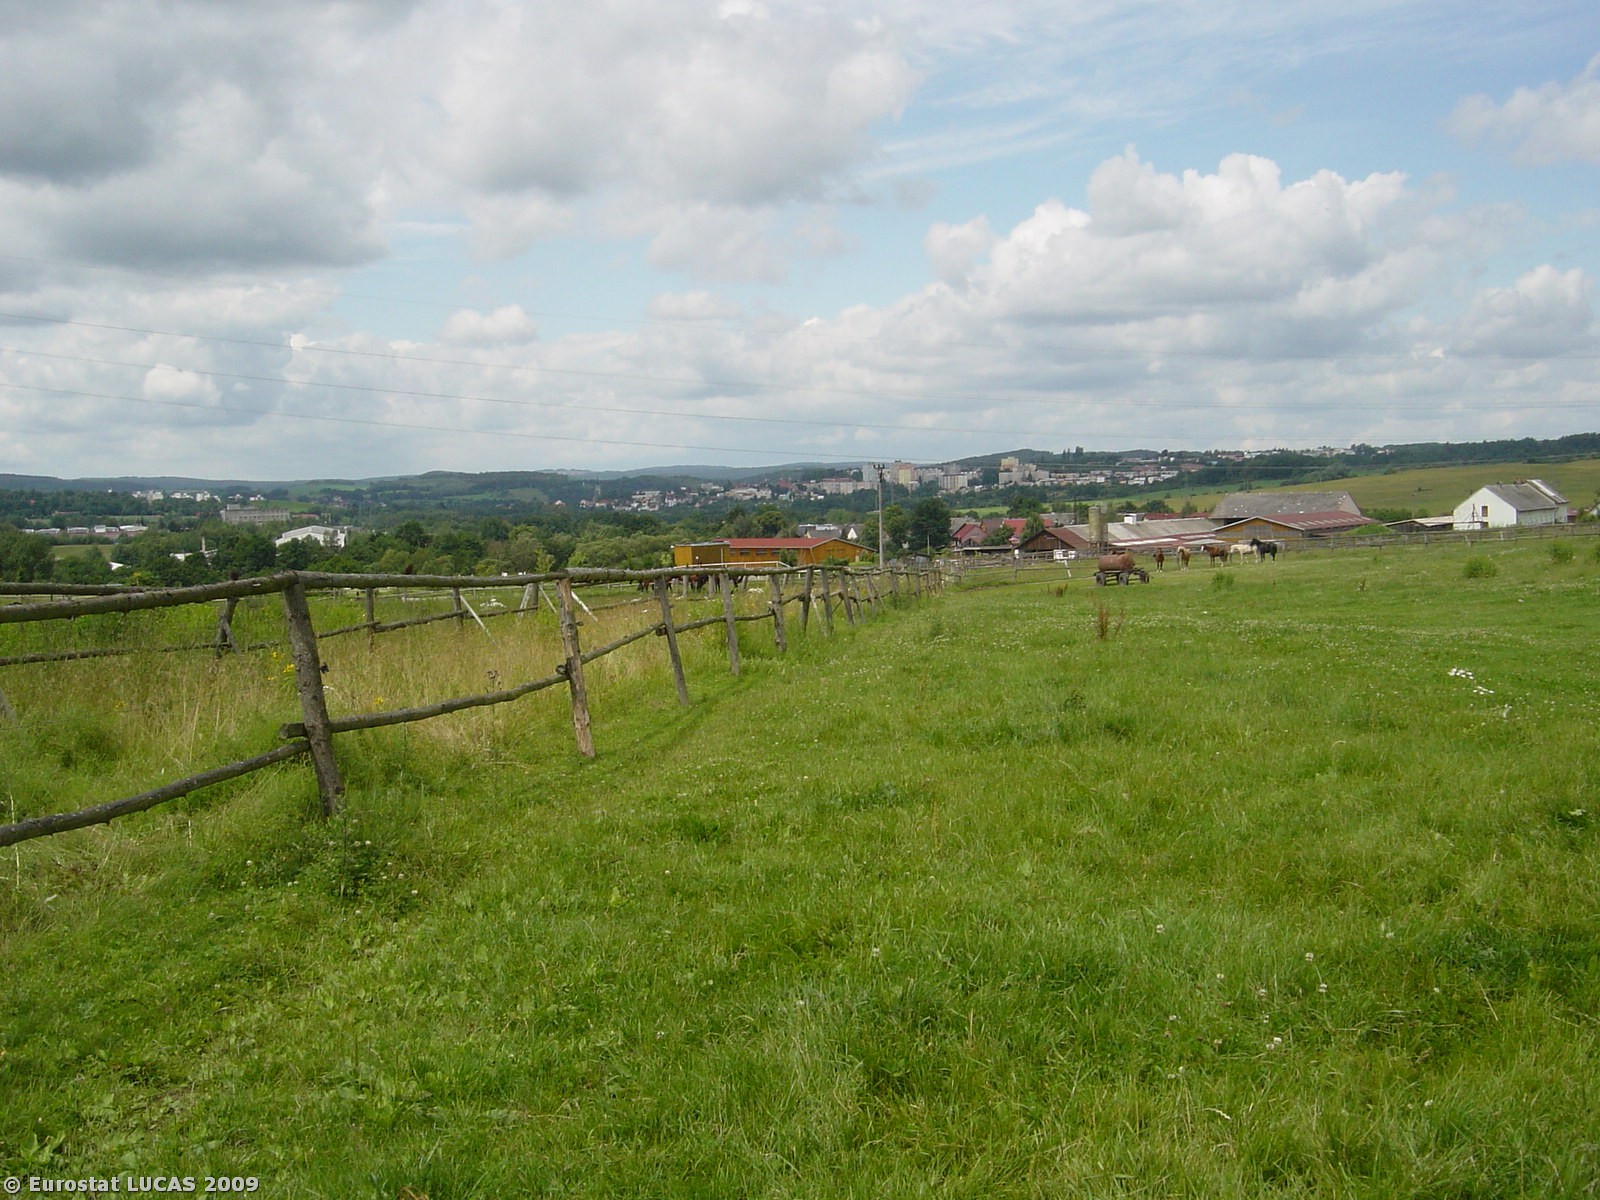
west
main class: Grassland
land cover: Grassland without tree/shrub cover
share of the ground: > 75 %
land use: Agriculture (excluding fallow land and kitchen gardens)
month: July
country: CZ
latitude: 49.7929
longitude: 12.6807
